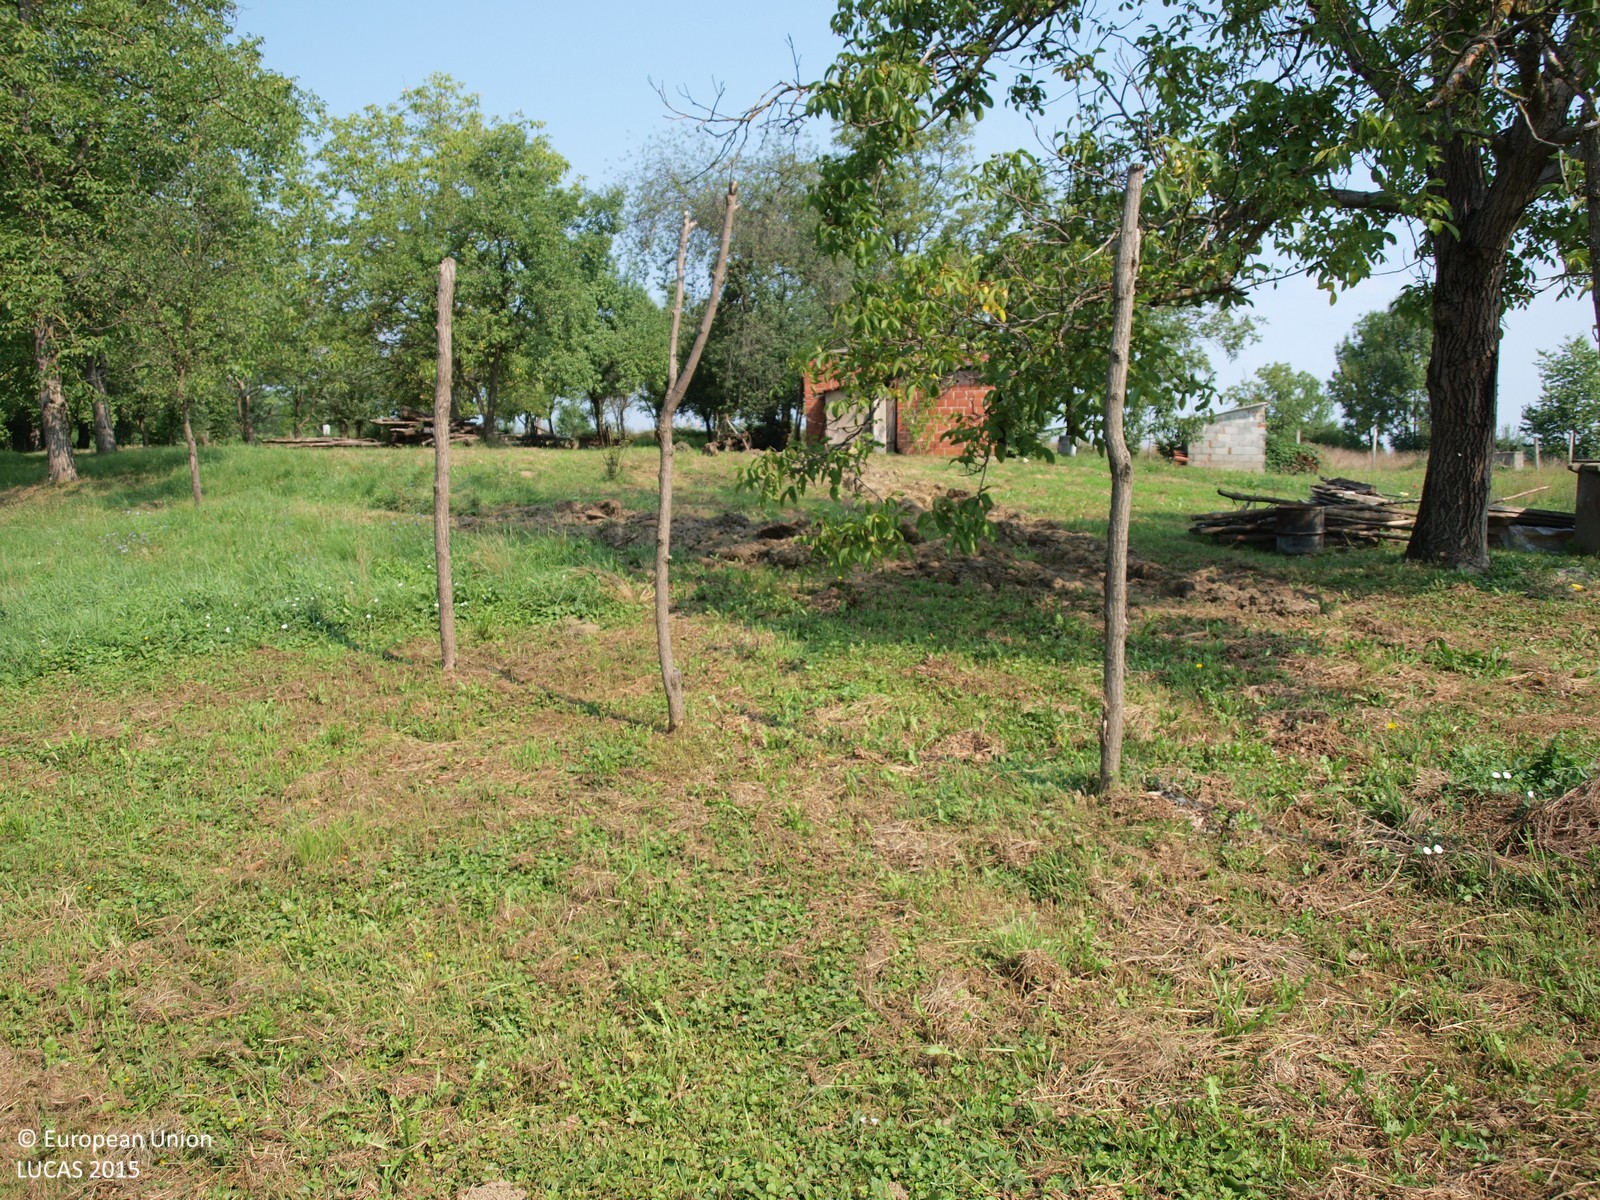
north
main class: Cropland
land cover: Tomatoes
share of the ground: > 75 %
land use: Kitchen garden
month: August
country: HR
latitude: 45.9046
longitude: 16.4315
